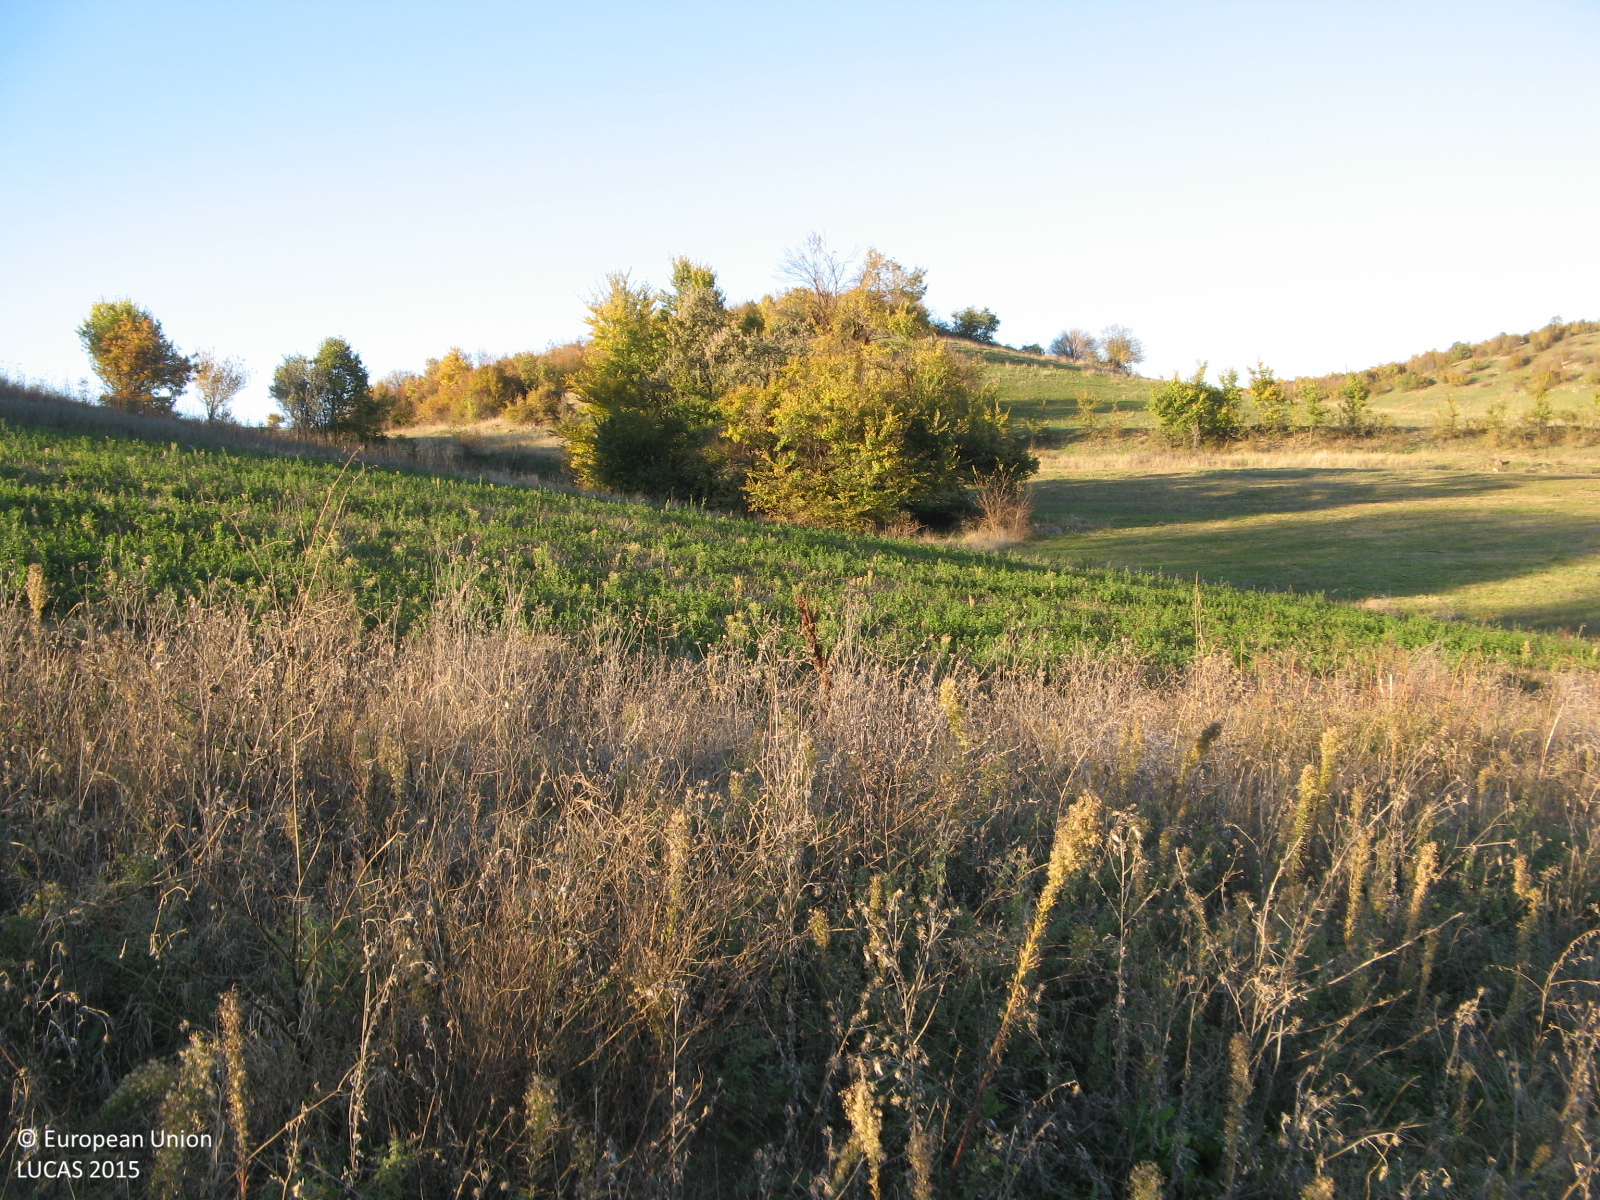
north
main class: Grassland
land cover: Spontaneously vegetated surfaces
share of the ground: > 75 %
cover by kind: herbaceous plants 100 %
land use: Fallow land
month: November
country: BG
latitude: 41.7559
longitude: 25.3195
